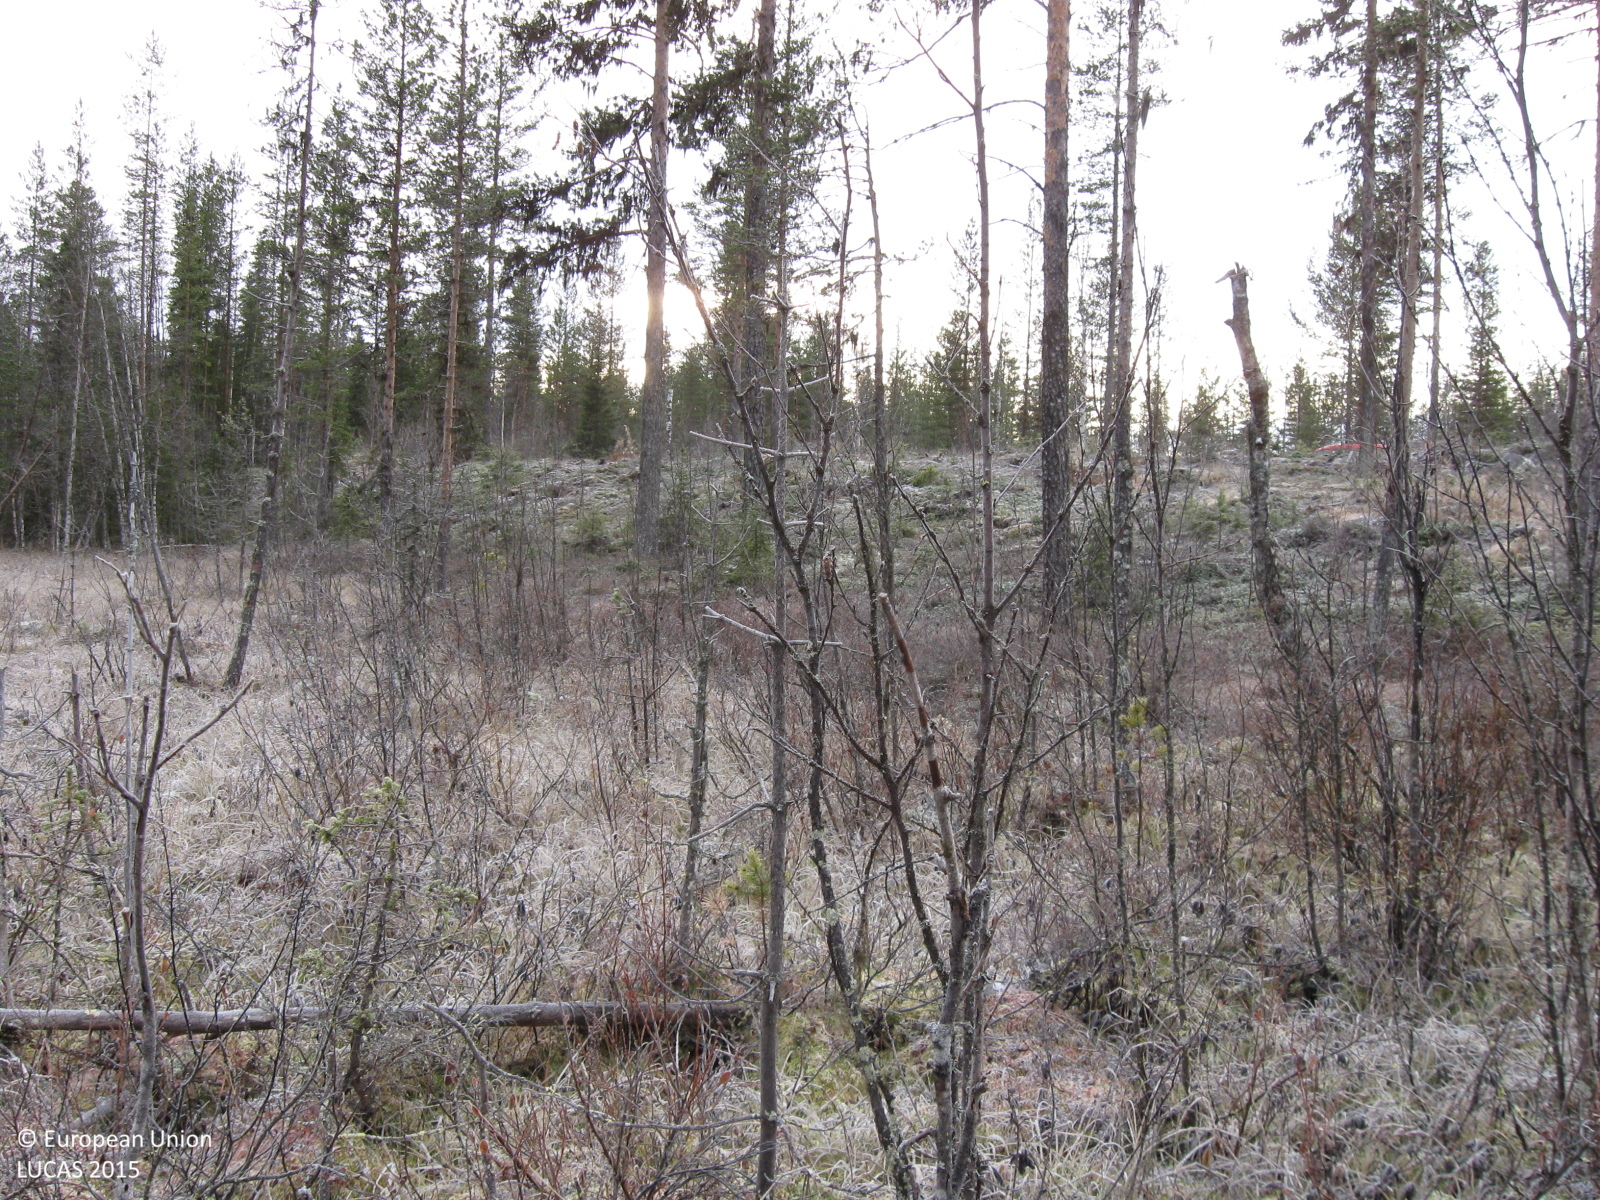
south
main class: Woodland
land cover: Pine dominated mixed woodland
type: mire and swamp forests
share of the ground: 25 - 50 %
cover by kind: lichens and mosses 30 %, shrubs 25 %, herbaceous plants 20 %, broadleaved forest trees 15 %, coniferous forest trees 10 %
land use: Semi-natural and natural areas not in use
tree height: > 5 m
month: October
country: SE
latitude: 66.2273
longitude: 21.5487
